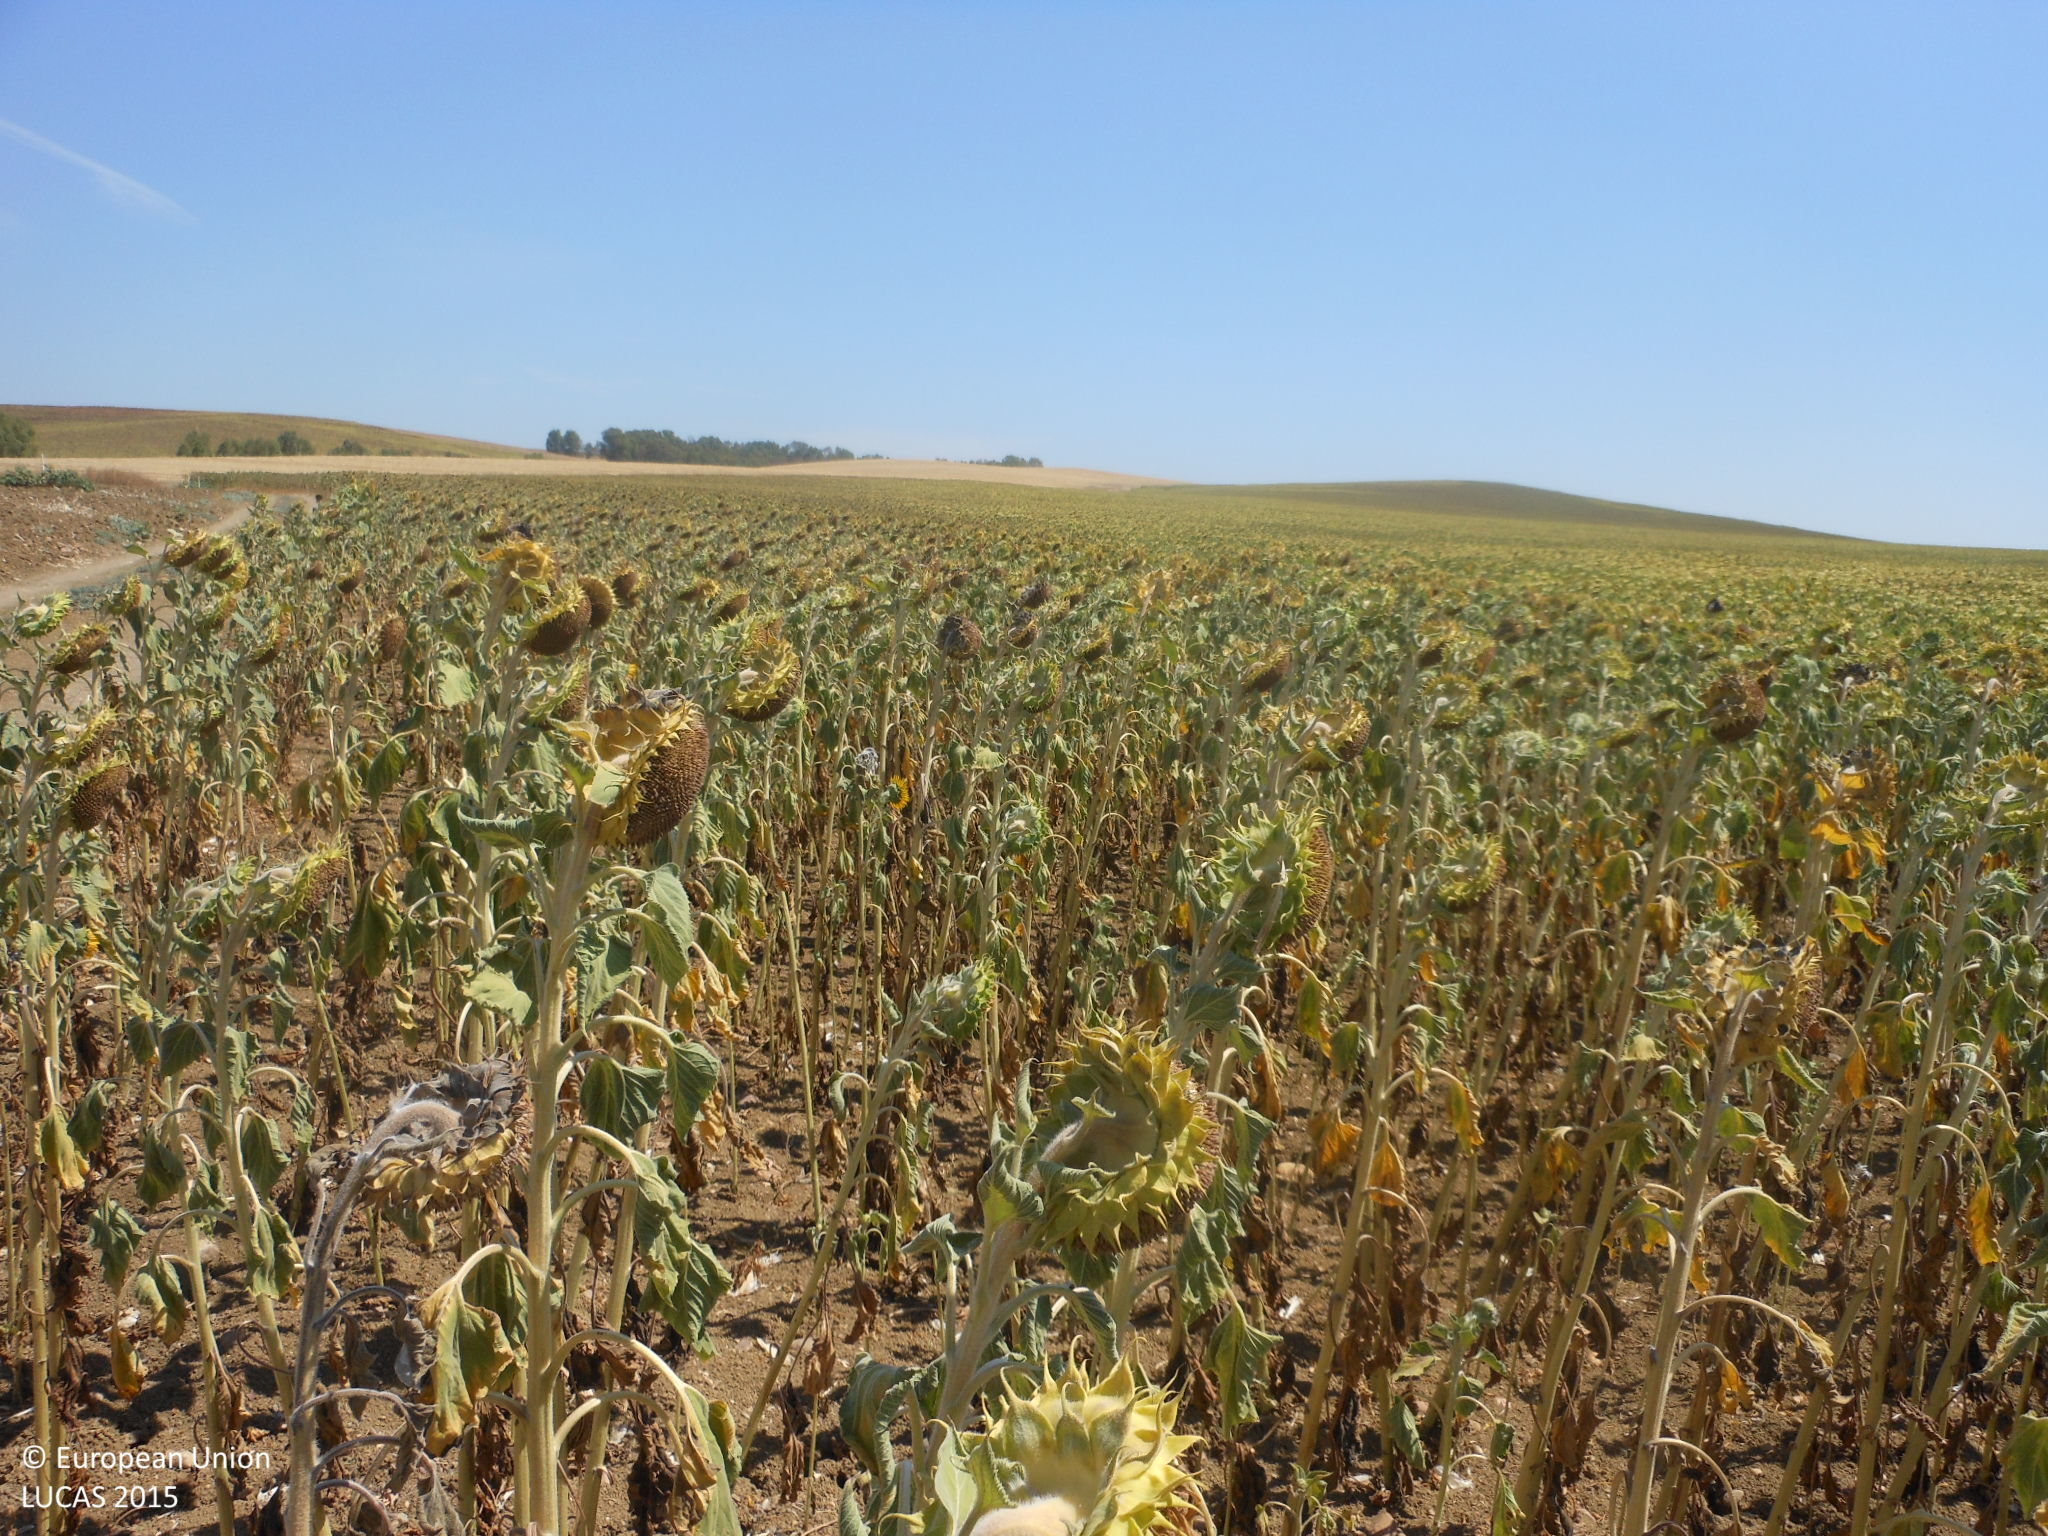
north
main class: Cropland
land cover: Sunflower
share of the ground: > 75 %
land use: Agriculture (excluding fallow land and kitchen gardens)
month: June
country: ES
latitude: 37.6495
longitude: -5.1466
